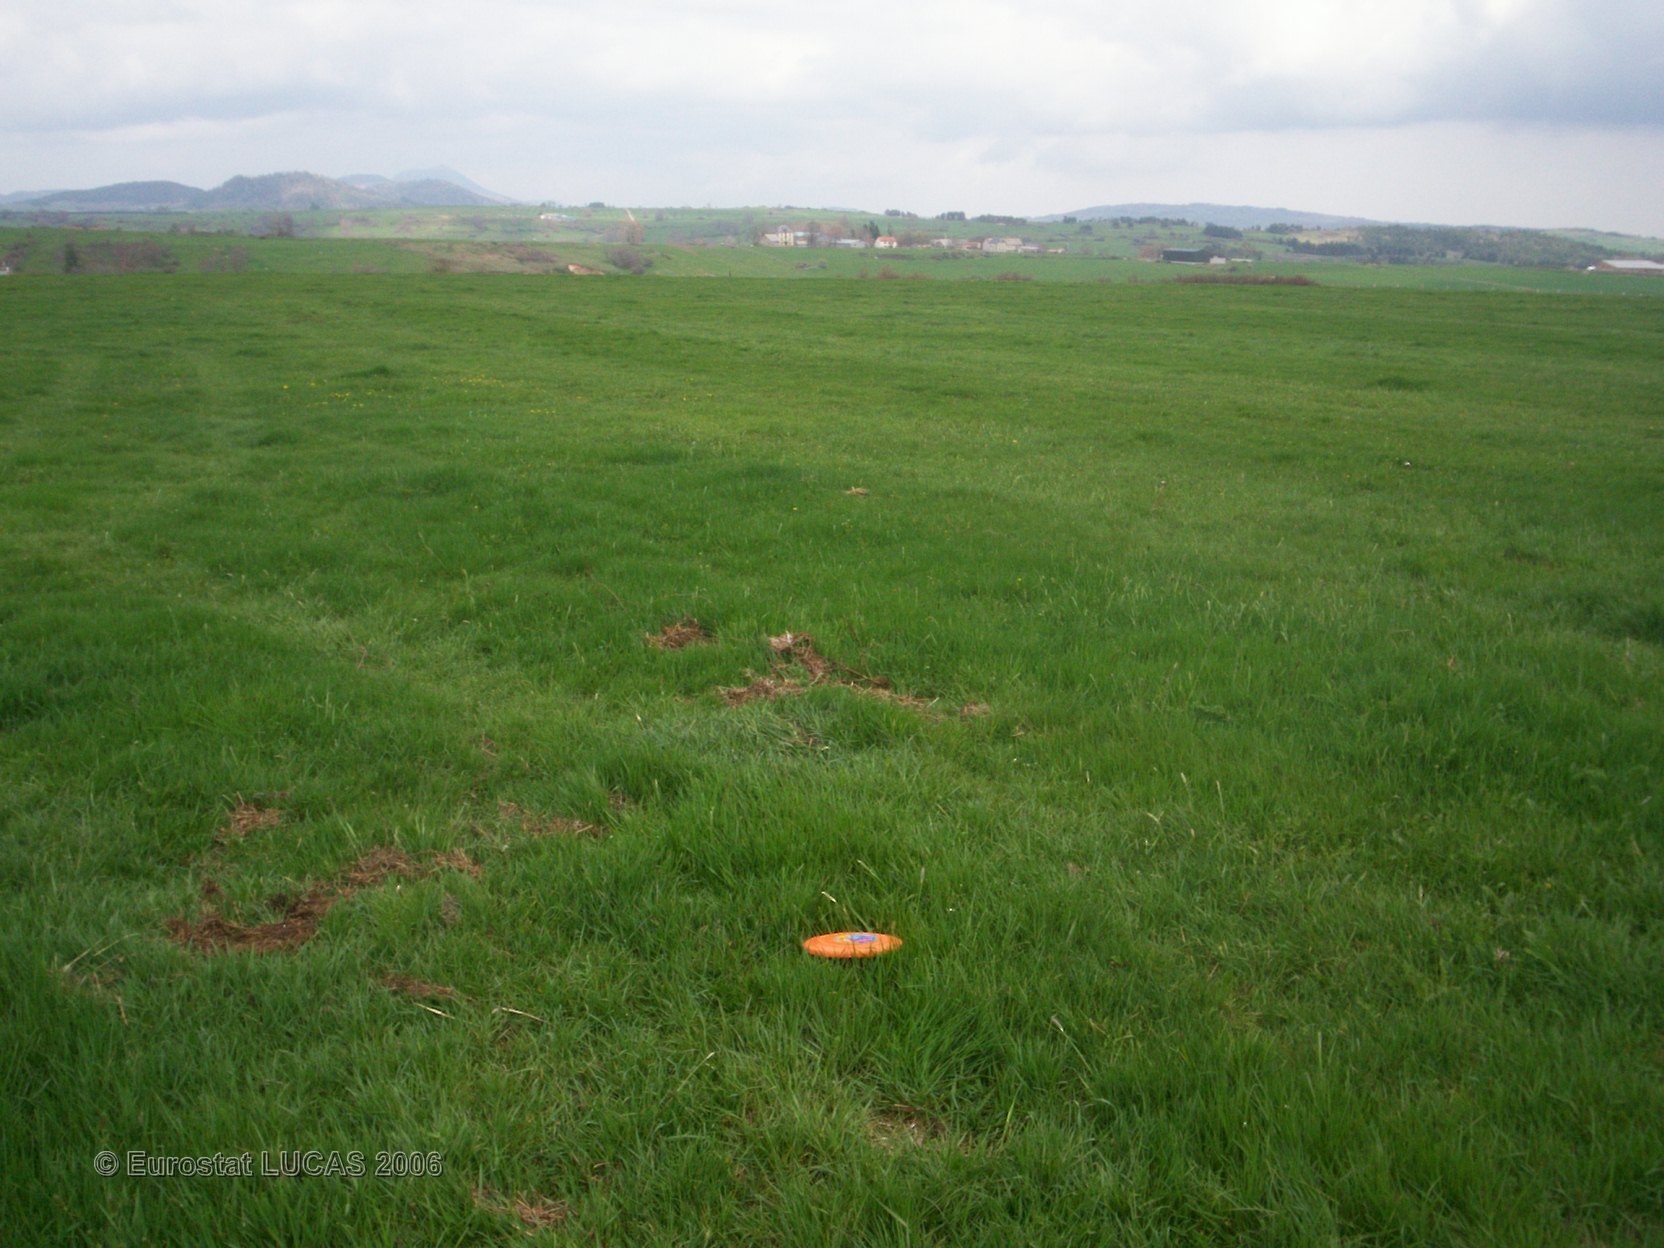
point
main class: Grassland
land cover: Grassland without tree/shrub cover
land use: Agriculture (excluding fallow land and kitchen gardens)
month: April
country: FR
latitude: 45.6129
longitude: 2.9598
